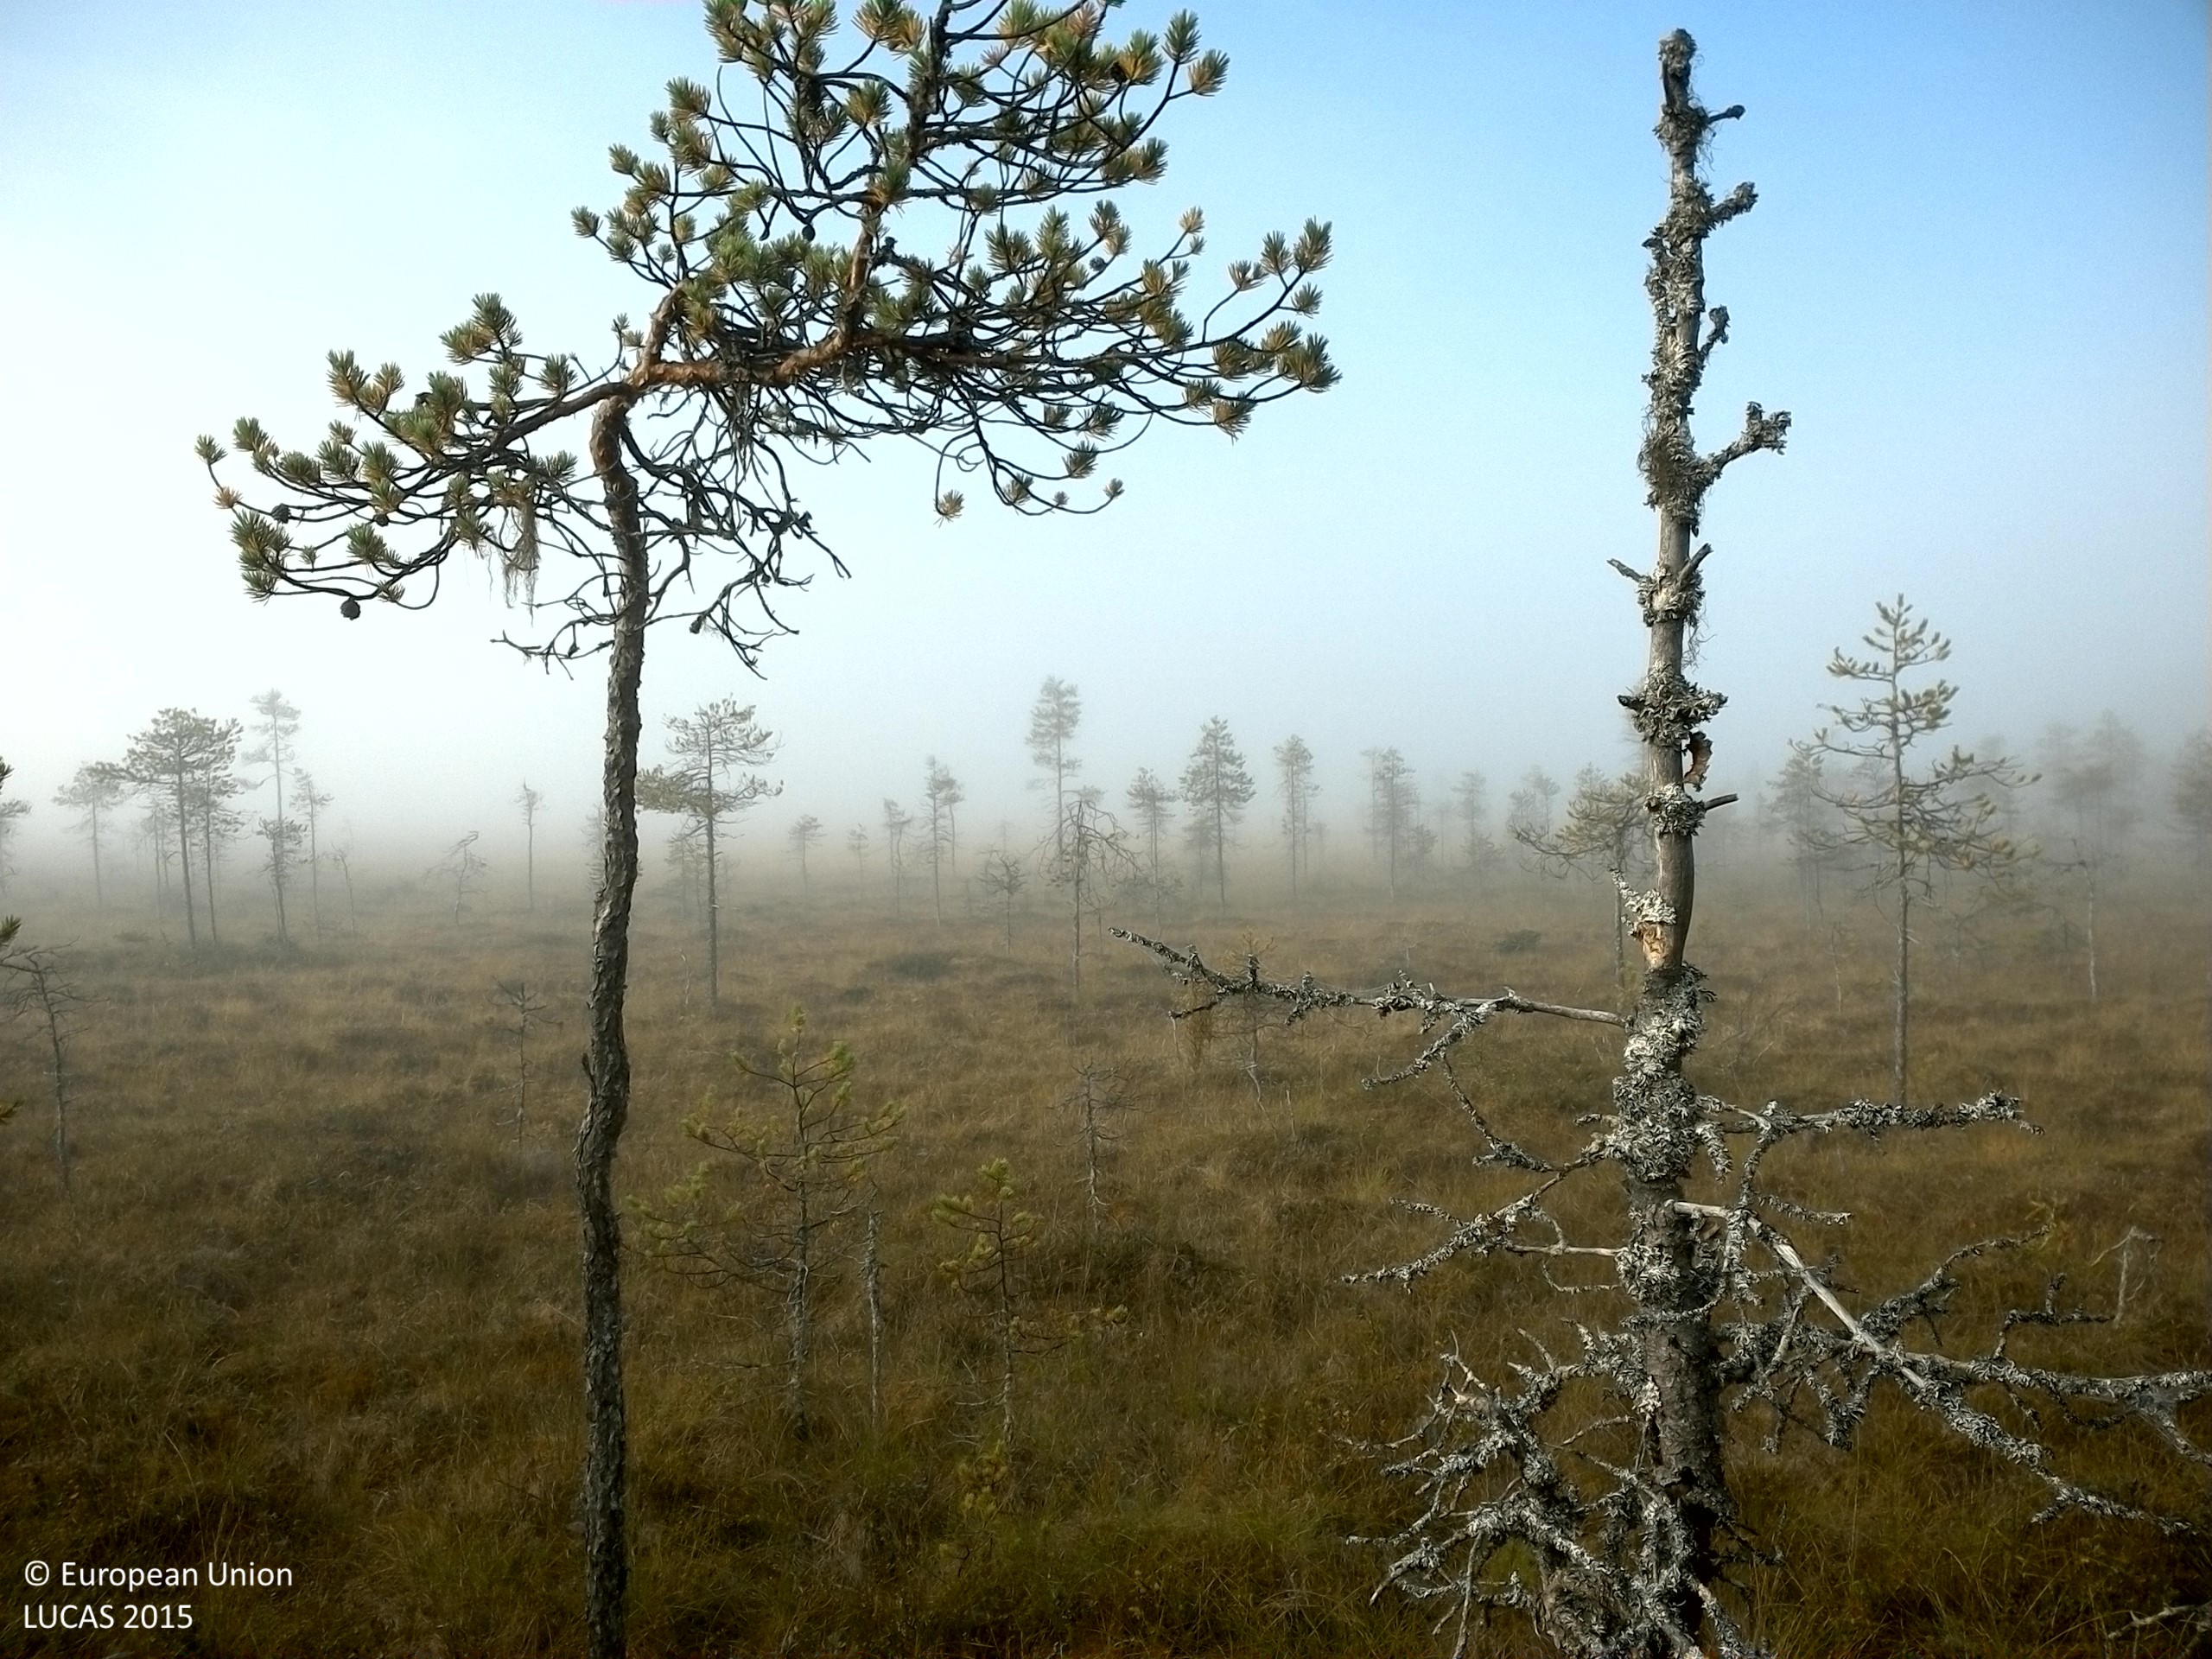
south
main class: Woodland
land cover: Pine dominated coniferous woodland
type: boreal forest
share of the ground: 10 - 25 %
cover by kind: lichens and mosses 40 %, herbaceous plants 25 %, shrubs 20 %, coniferous forest trees 15 %
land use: Semi-natural and natural areas not in use
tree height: < 5 m
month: September
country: SE
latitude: 64.0143
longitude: 17.6418
